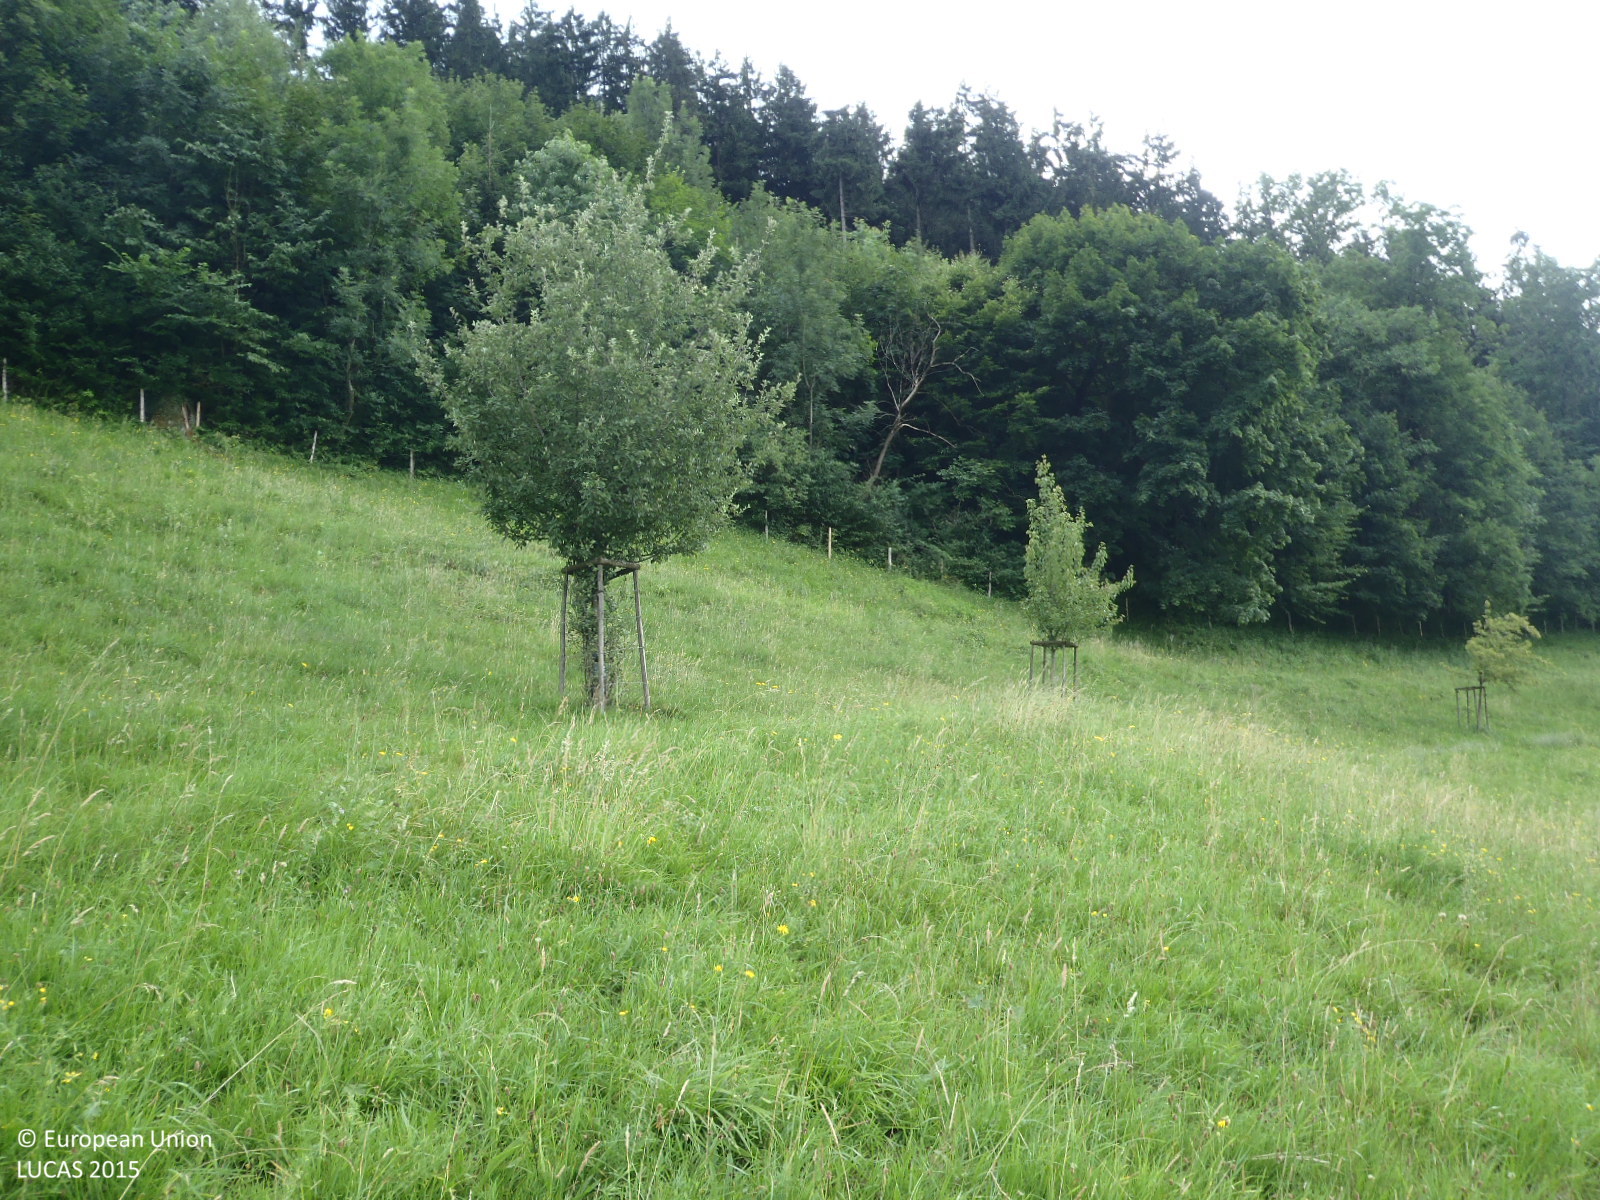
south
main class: Grassland
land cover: Grassland without tree/shrub cover
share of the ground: > 75 %
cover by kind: herbaceous plants 100 %
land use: Agriculture (excluding fallow land and kitchen gardens)
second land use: Amenities, museums, leisure
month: July
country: AT
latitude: 47.2328
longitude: 9.5909
